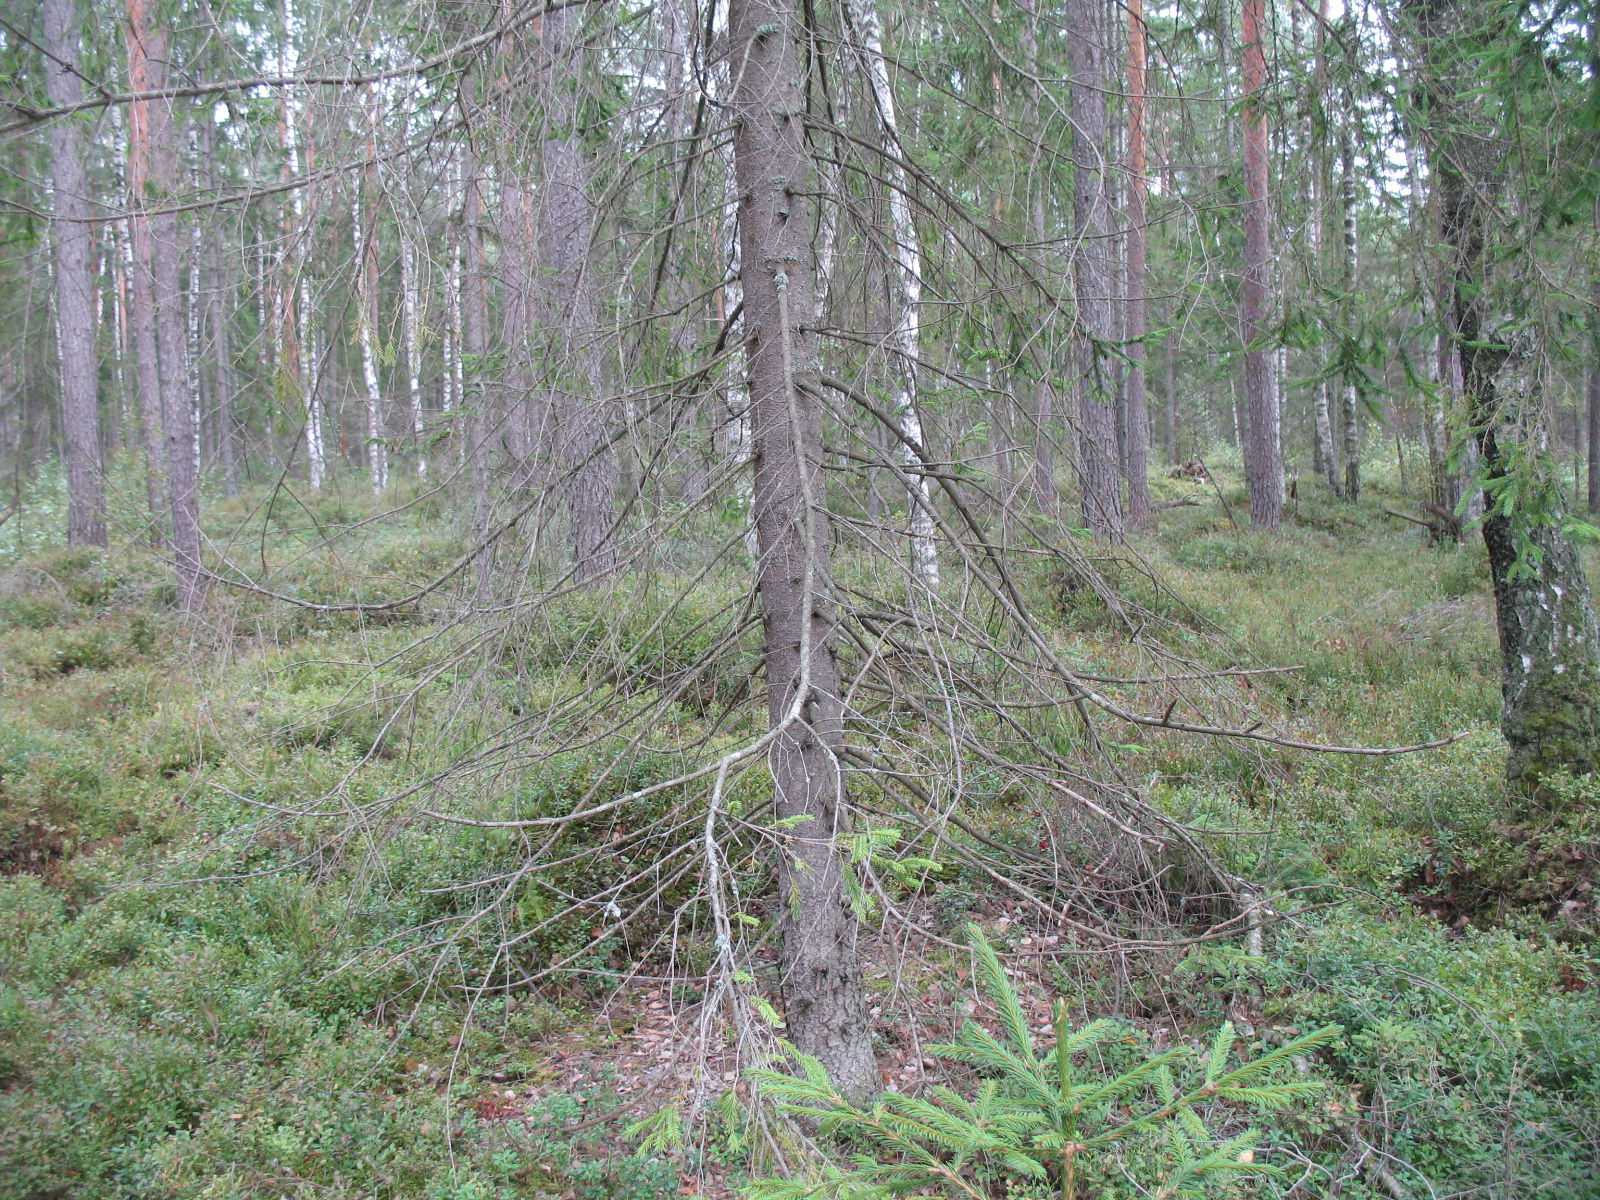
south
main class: Woodland
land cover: Other mixed woodland
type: hemiboreal forest and nemoral coniferous forest and mixed broadleaved-coniferous forest
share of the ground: 25 - 50 %
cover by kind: coniferous forest trees 25 %, herbaceous plants 25 %, lichens and mosses 25 %, broadleaved forest trees 20 %, shrubs 5 %
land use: Forestry
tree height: > 5 m
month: September
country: LV
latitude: 56.1531
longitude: 25.9589
